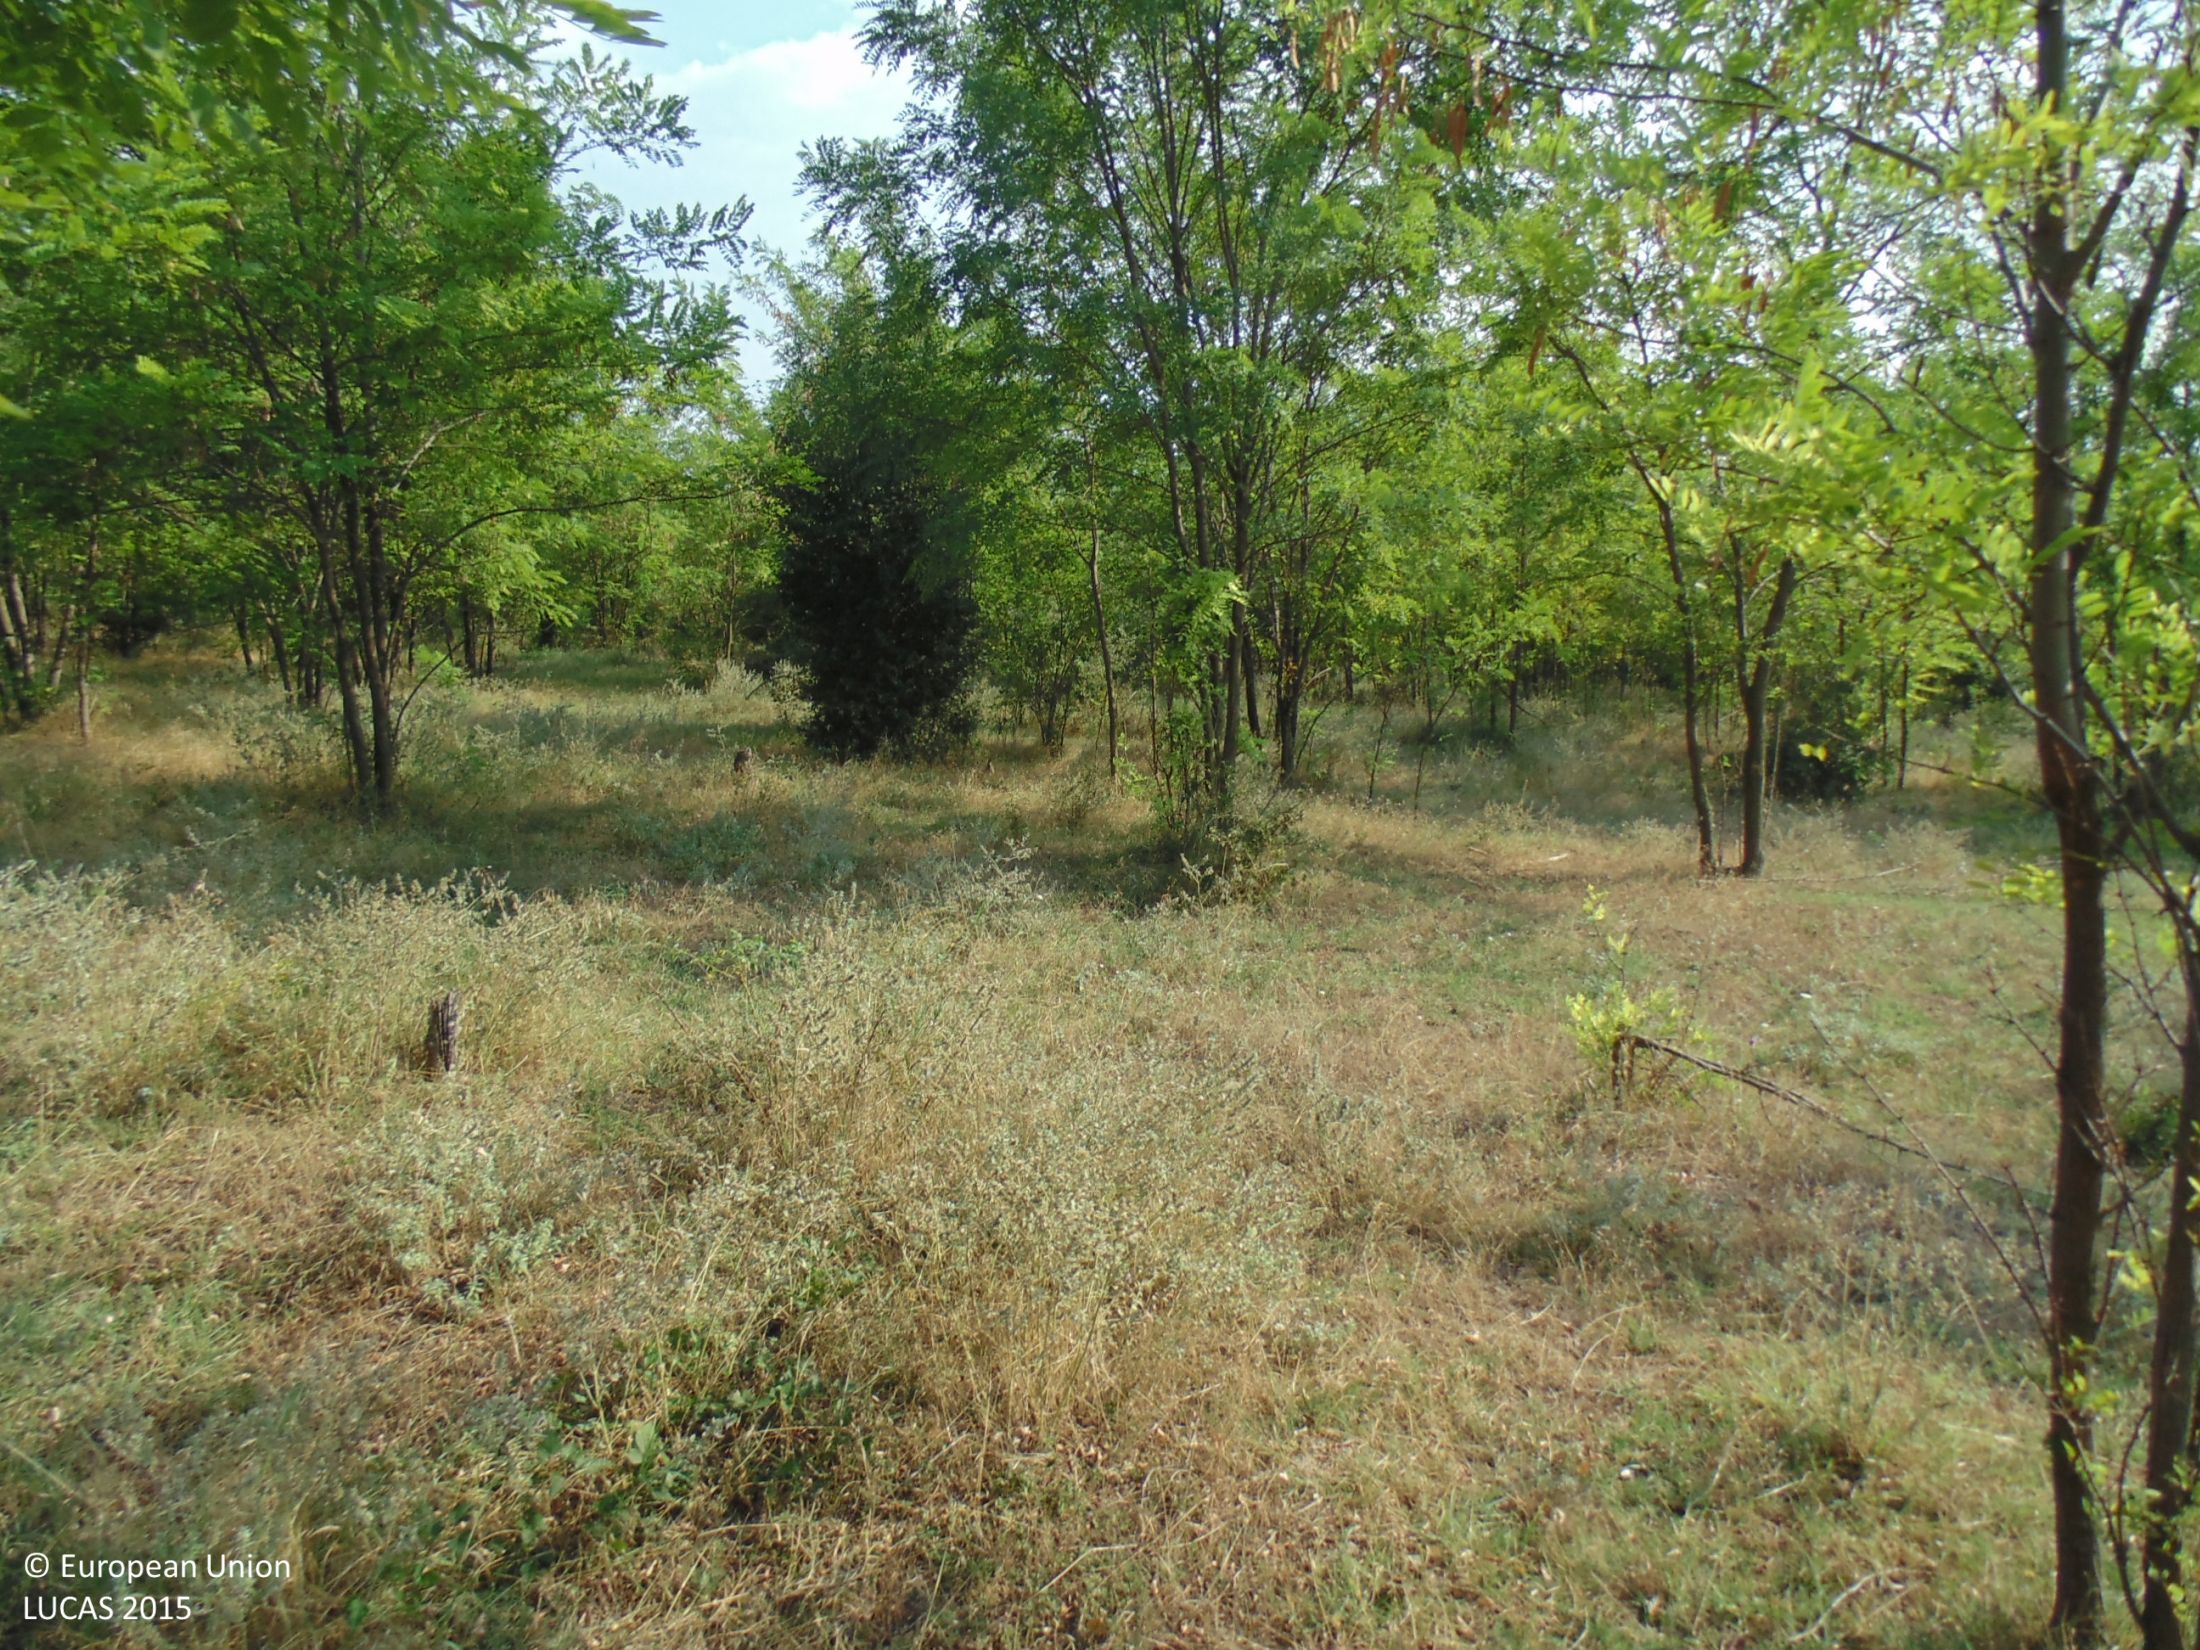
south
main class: Woodland
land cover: Broadleaved woodland
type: mesophytic deciduous forest
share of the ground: > 75 %
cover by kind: broadleaved forest trees 90 %, shrubs 5 %, unconsolidated bare surface 5 %
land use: Forestry
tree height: > 5 m
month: August
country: BG
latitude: 43.9512
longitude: 27.5197
